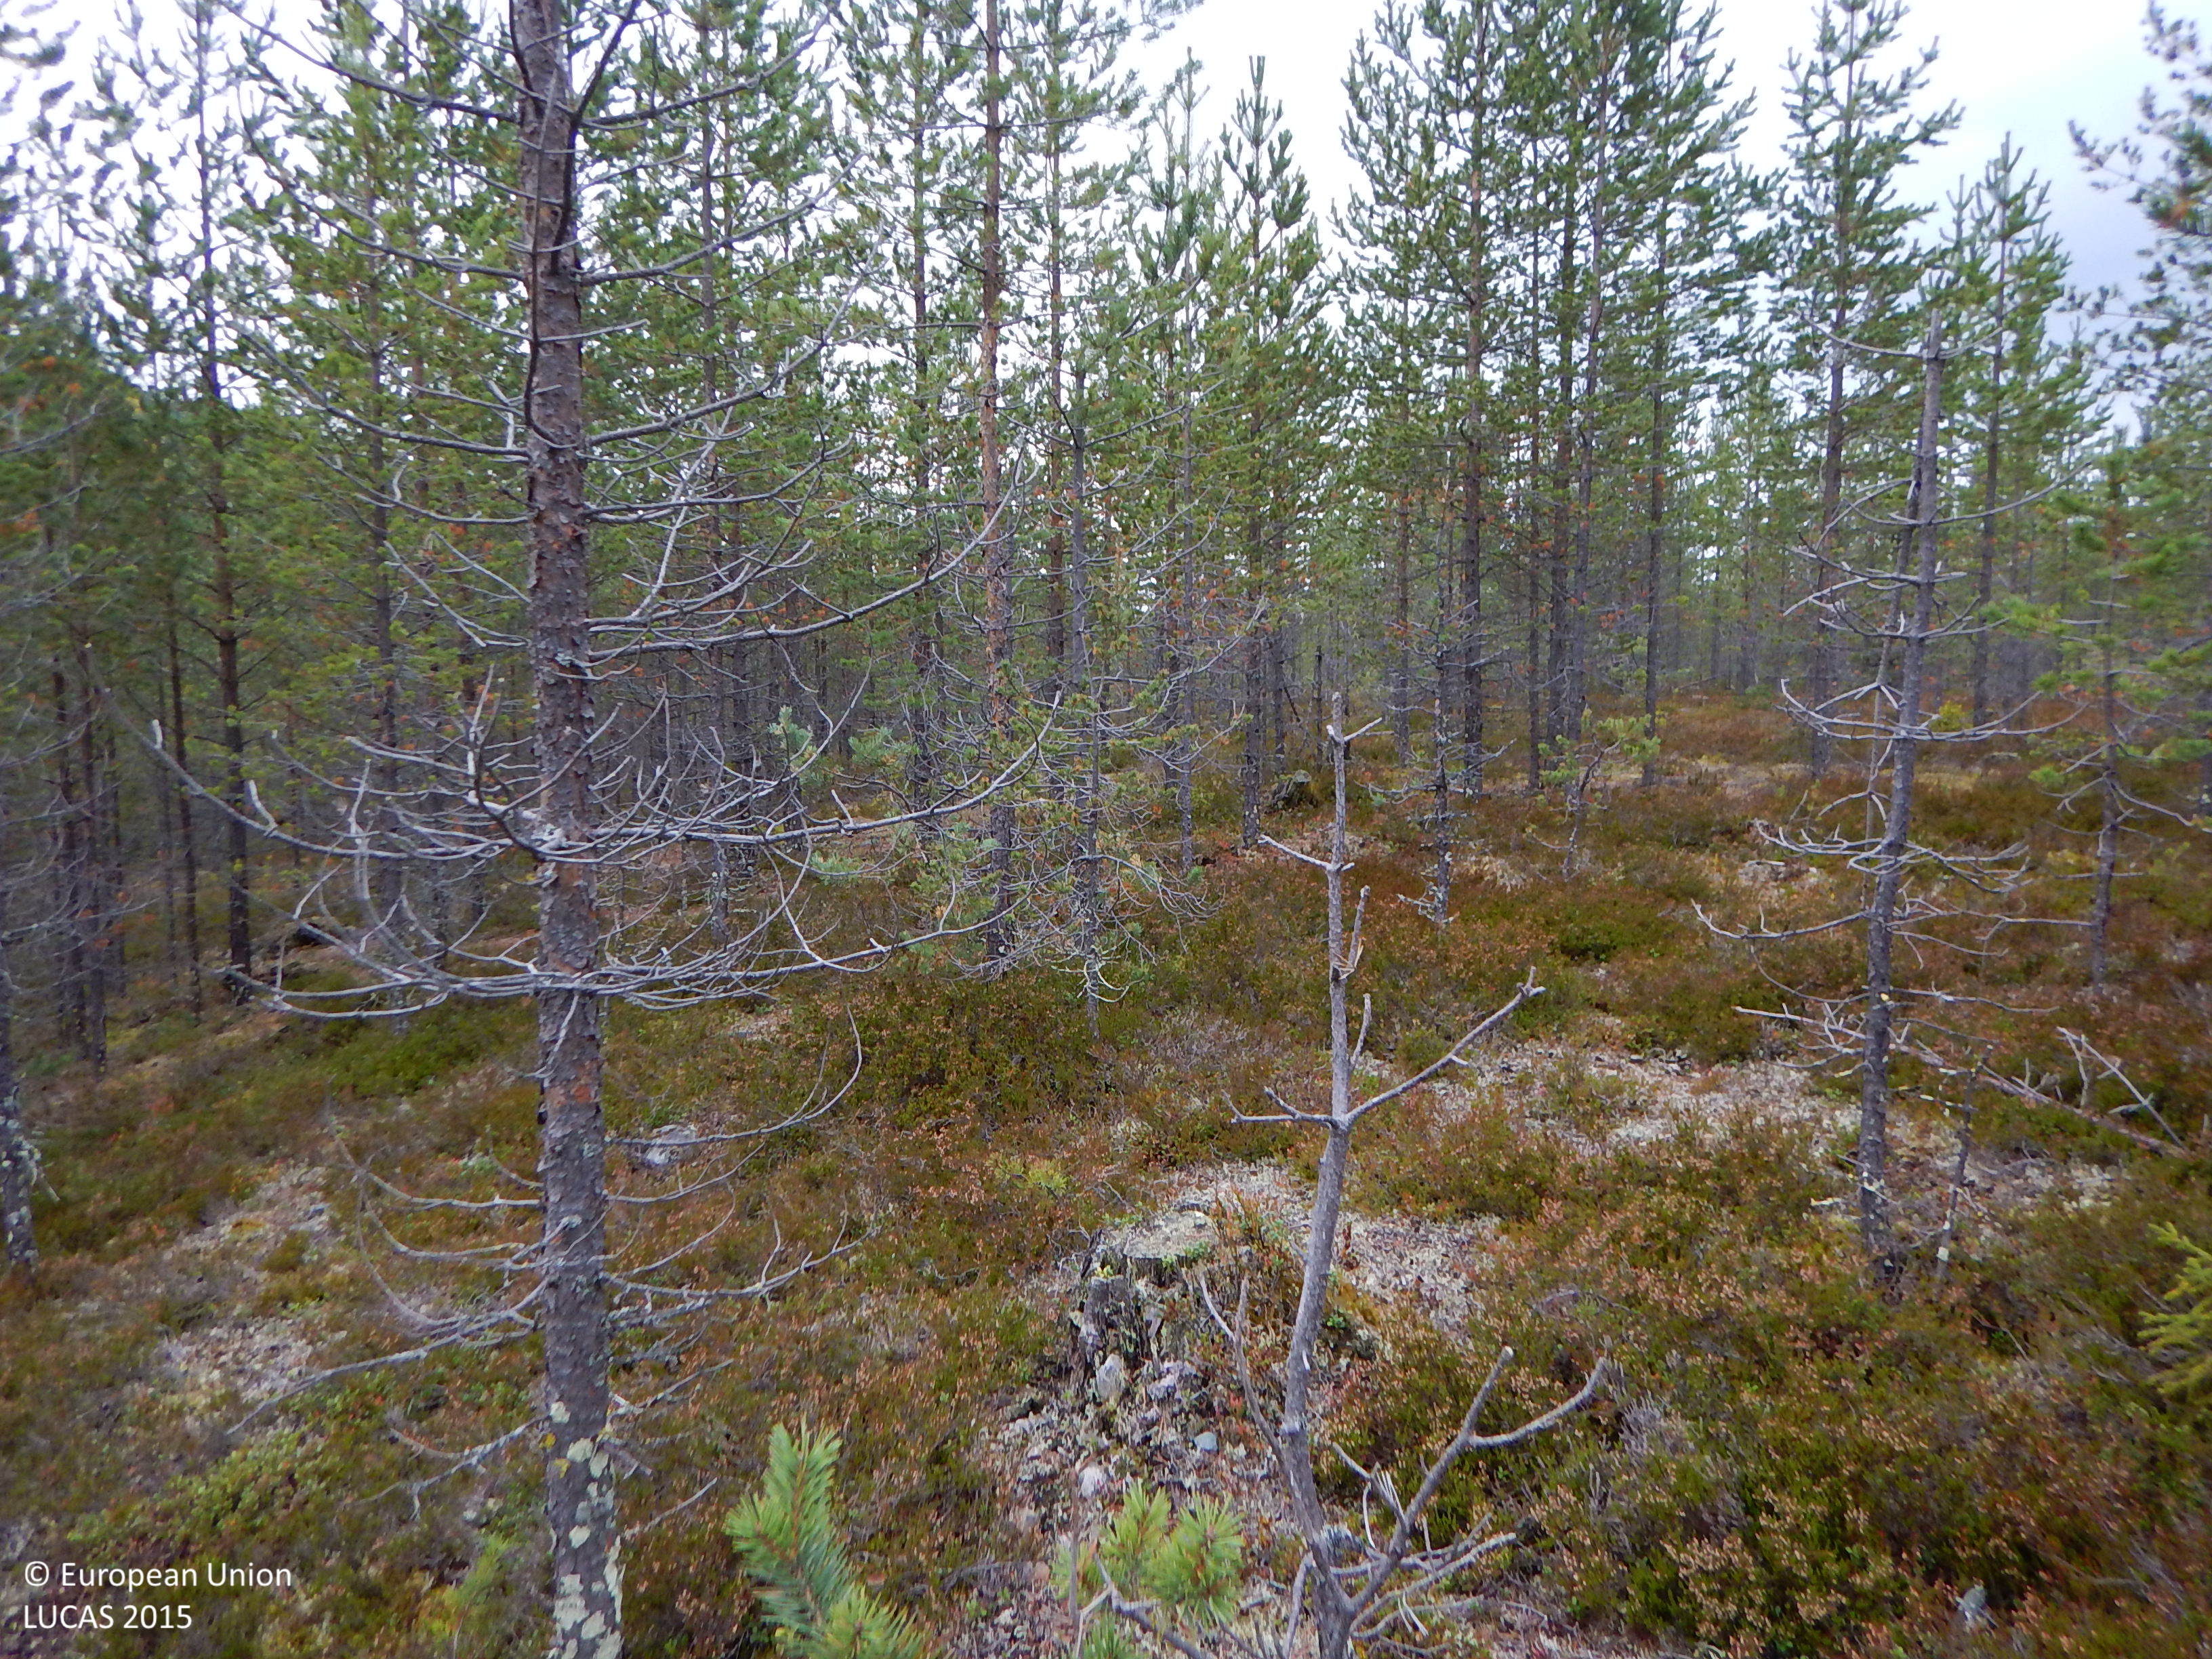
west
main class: Woodland
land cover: Pine dominated coniferous woodland
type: boreal forest
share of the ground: 50 - 75 %
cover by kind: coniferous forest trees 60 %, shrubs 15 %, lichens and mosses 15 %, herbaceous plants 5 %, unconsolidated bare surface 5 %
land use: Forestry
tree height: > 5 m
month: September
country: SE
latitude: 65.0790
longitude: 19.1749
